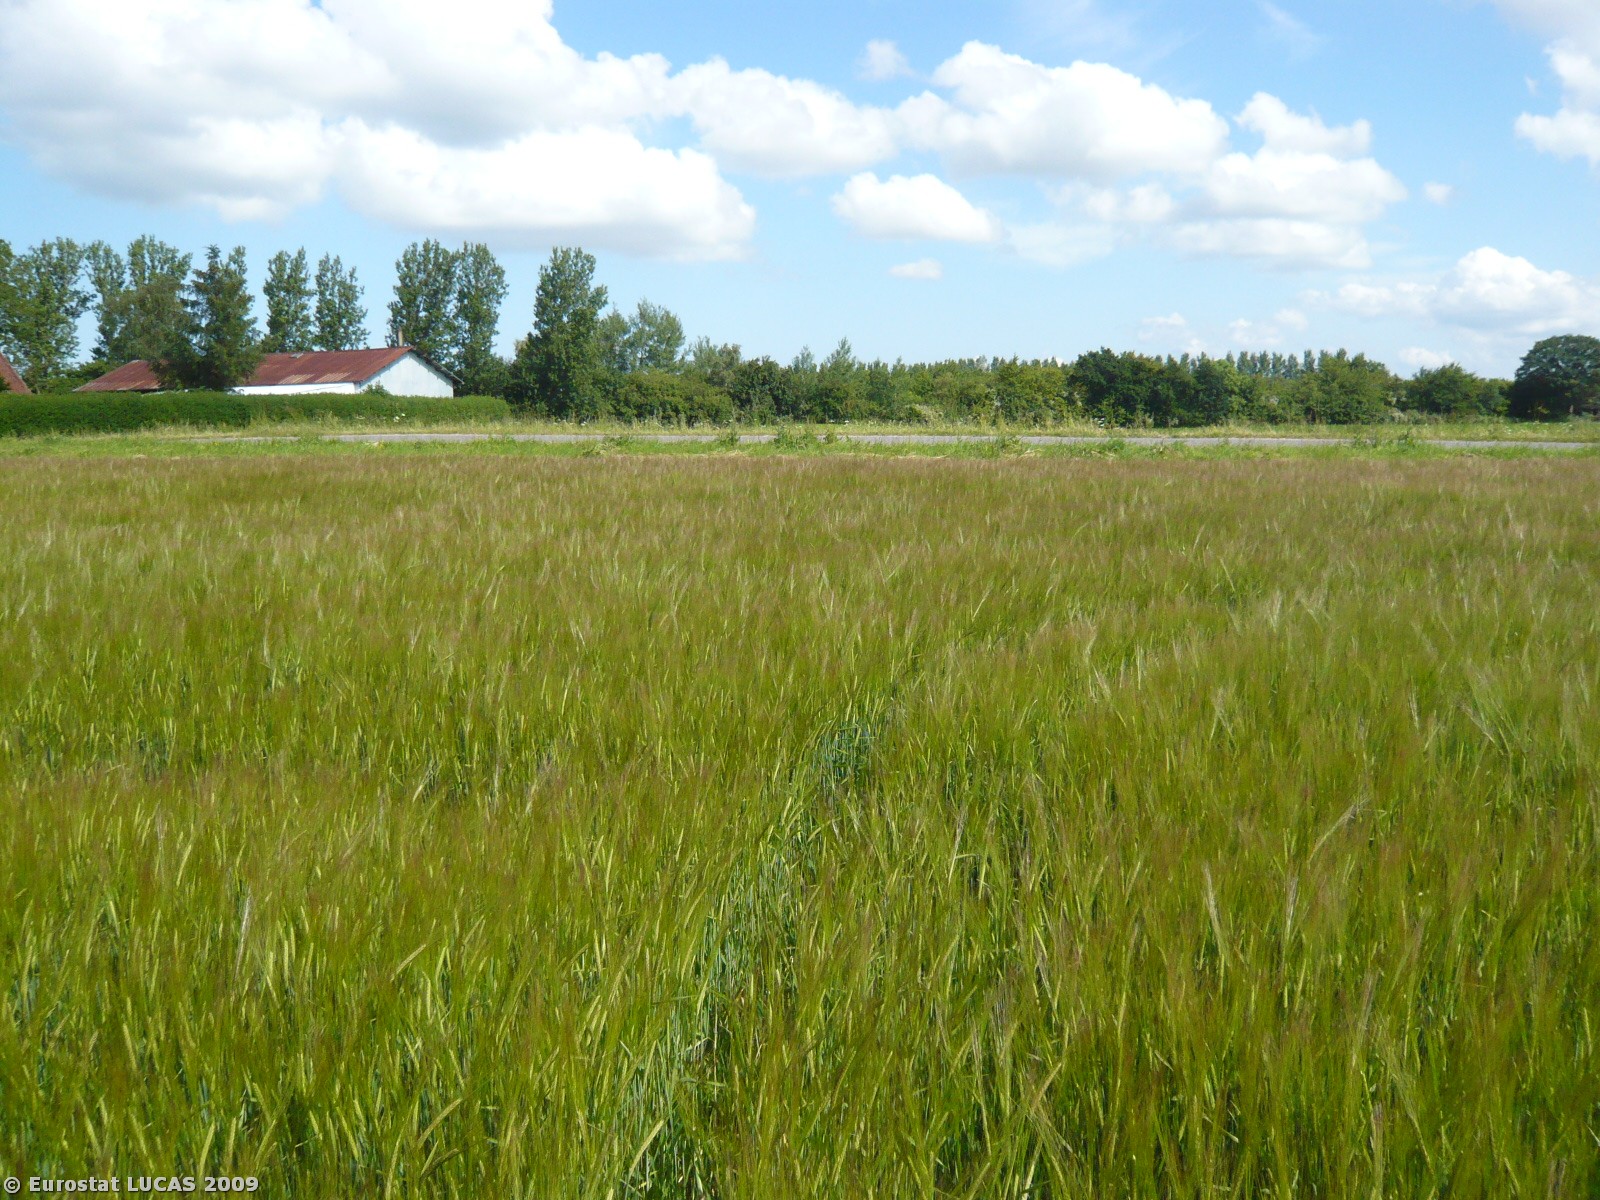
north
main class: Cropland
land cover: Barley
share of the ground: > 75 %
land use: Agriculture (excluding fallow land and kitchen gardens)
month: June
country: DK
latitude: 54.7208
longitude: 11.6601
